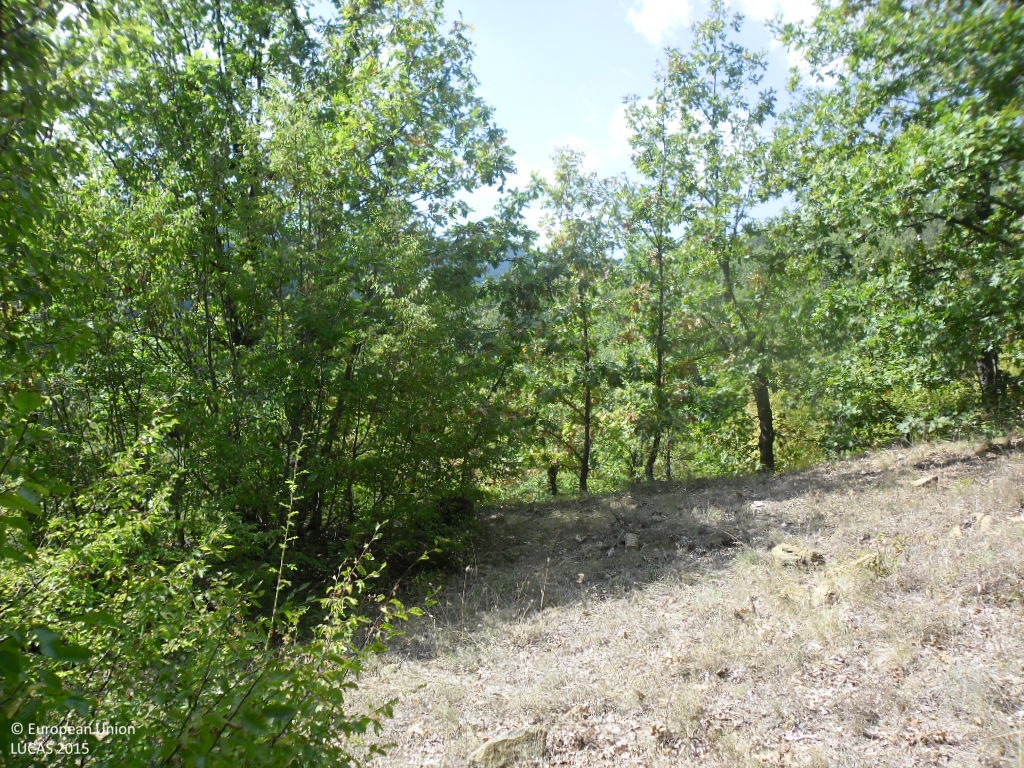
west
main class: Woodland
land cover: Broadleaved woodland
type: mesophytic deciduous forest
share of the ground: > 75 %
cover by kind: broadleaved forest trees 95 %, shrubs 5 %
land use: Forestry
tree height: > 5 m
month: September
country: BG
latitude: 41.8528
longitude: 22.9693
